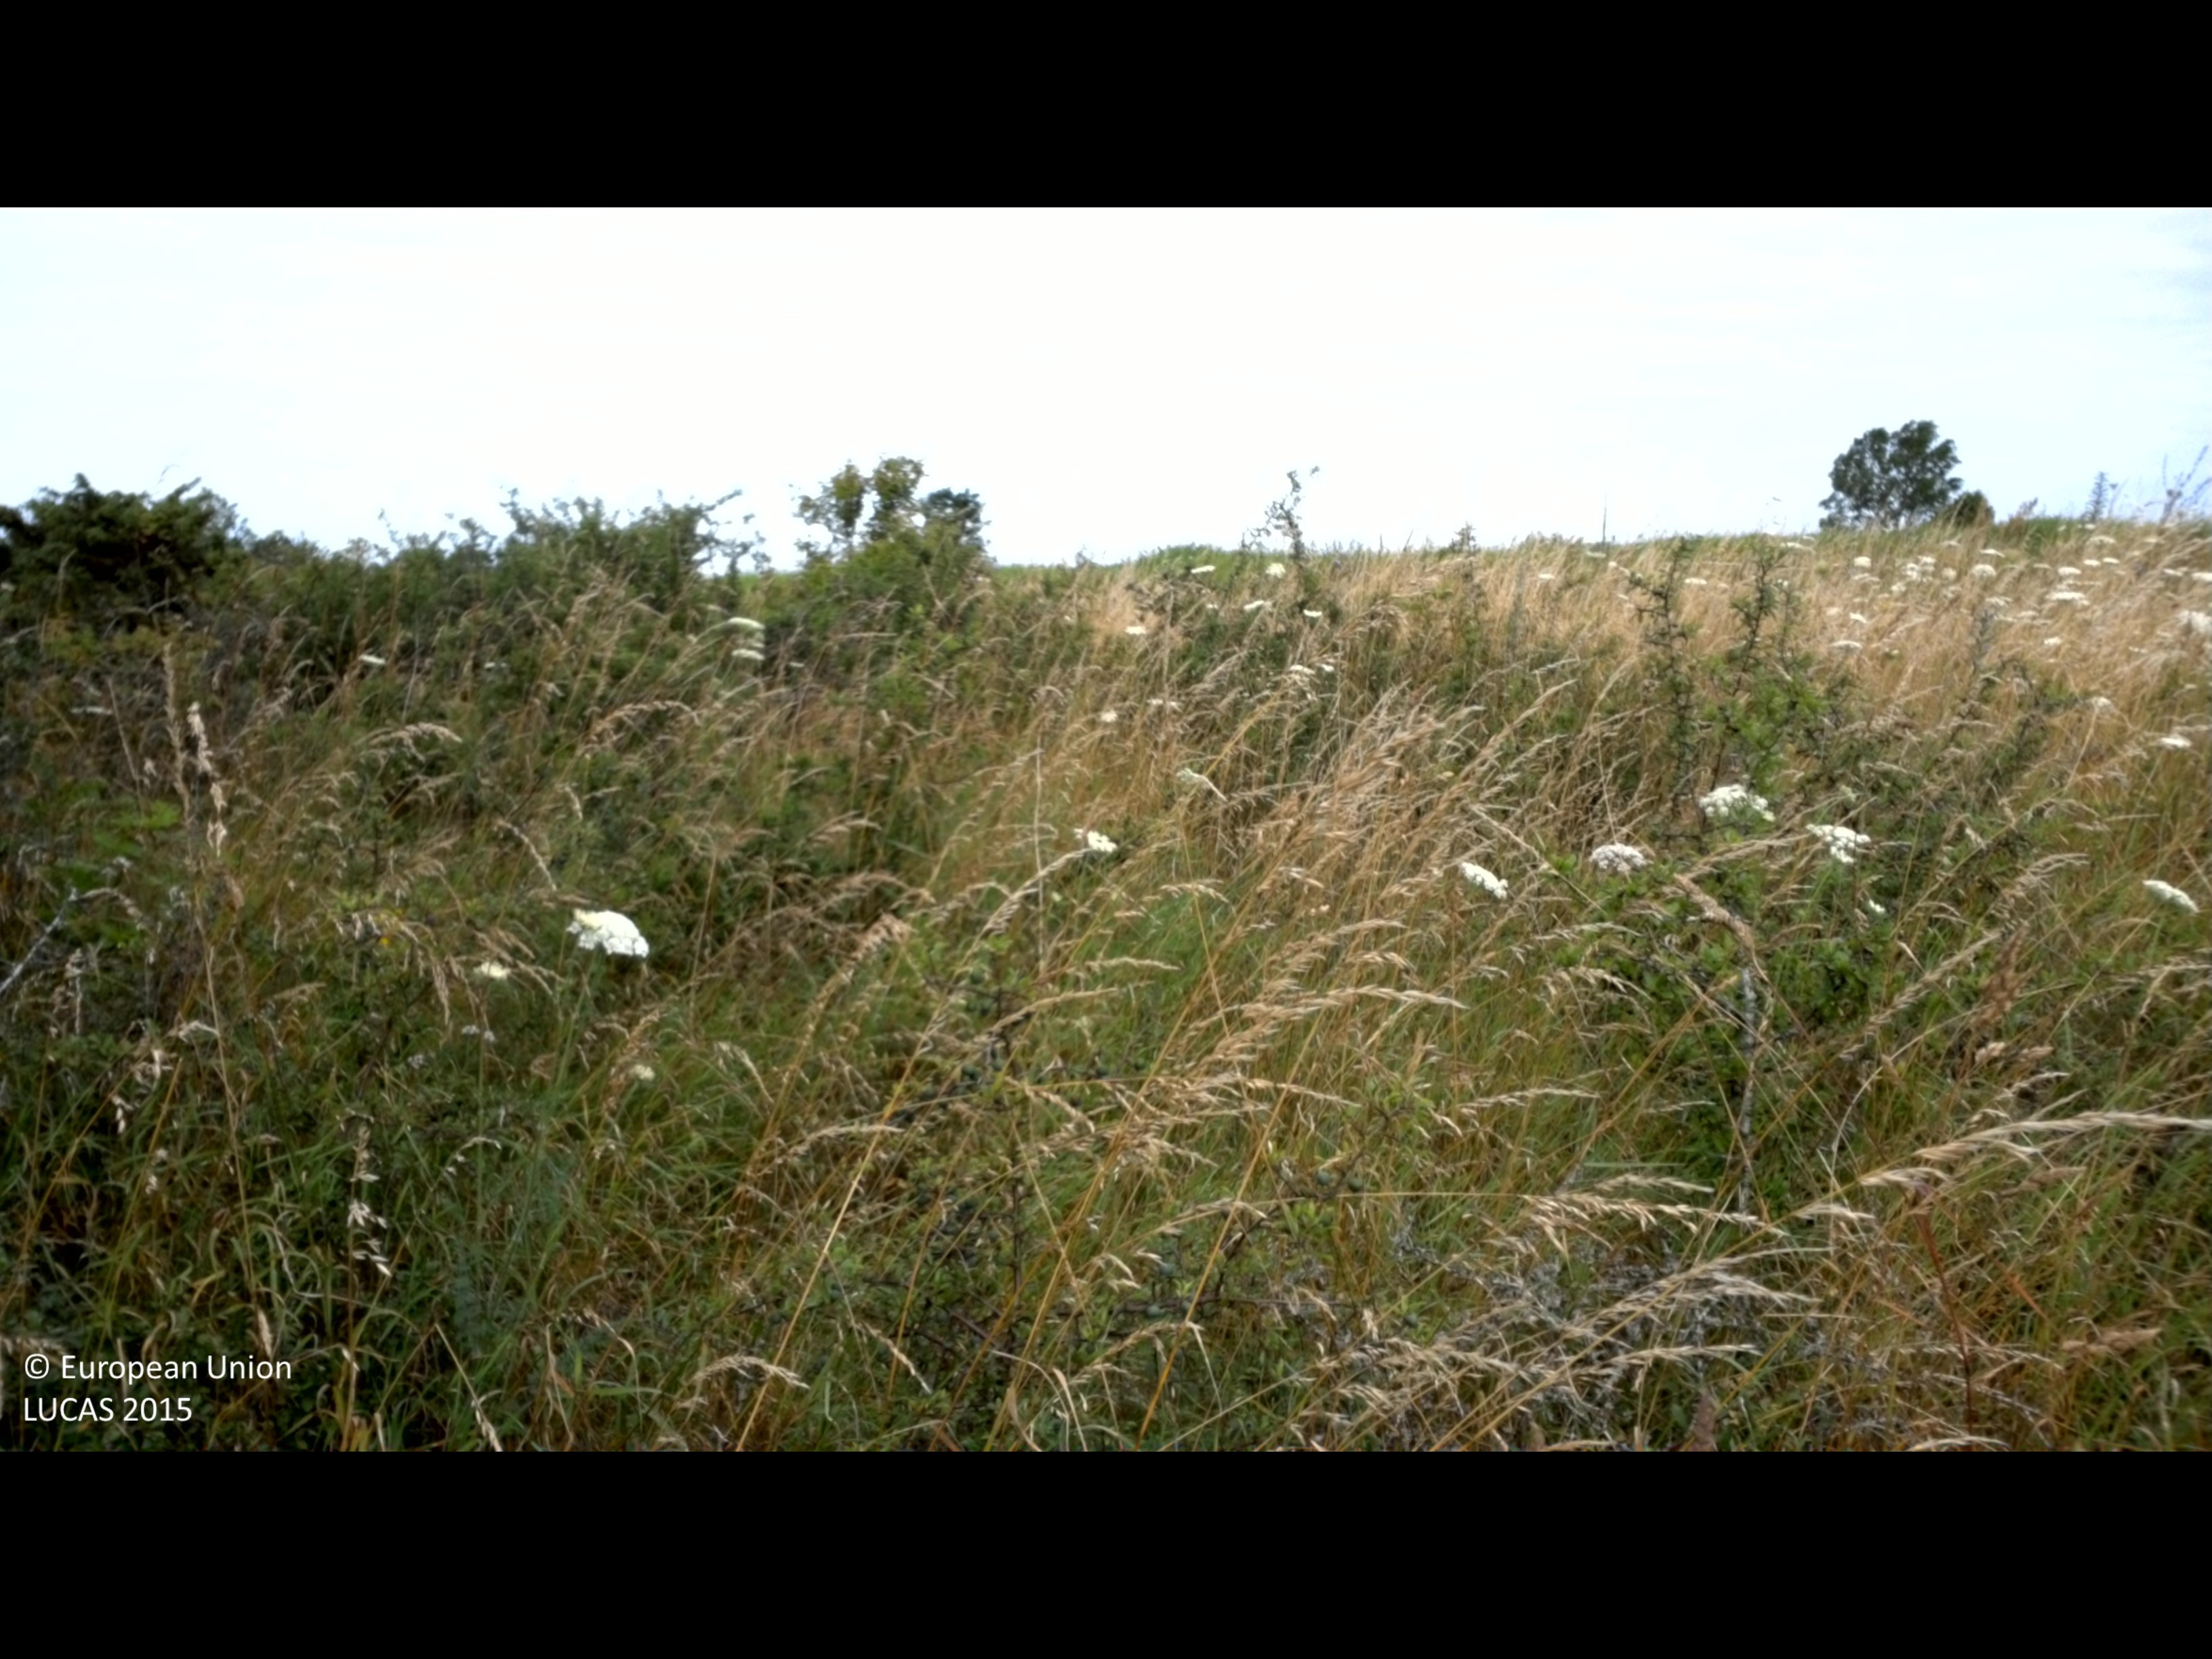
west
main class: Shrubland
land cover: Shrubland with sparse tree cover
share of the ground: > 75 %
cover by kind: shrubs 90 %, broadleaved forest trees 5 %, herbaceous plants 5 %
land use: Semi-natural and natural areas not in use
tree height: < 5 m
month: July
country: SE
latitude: 56.8459
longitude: 16.6414
